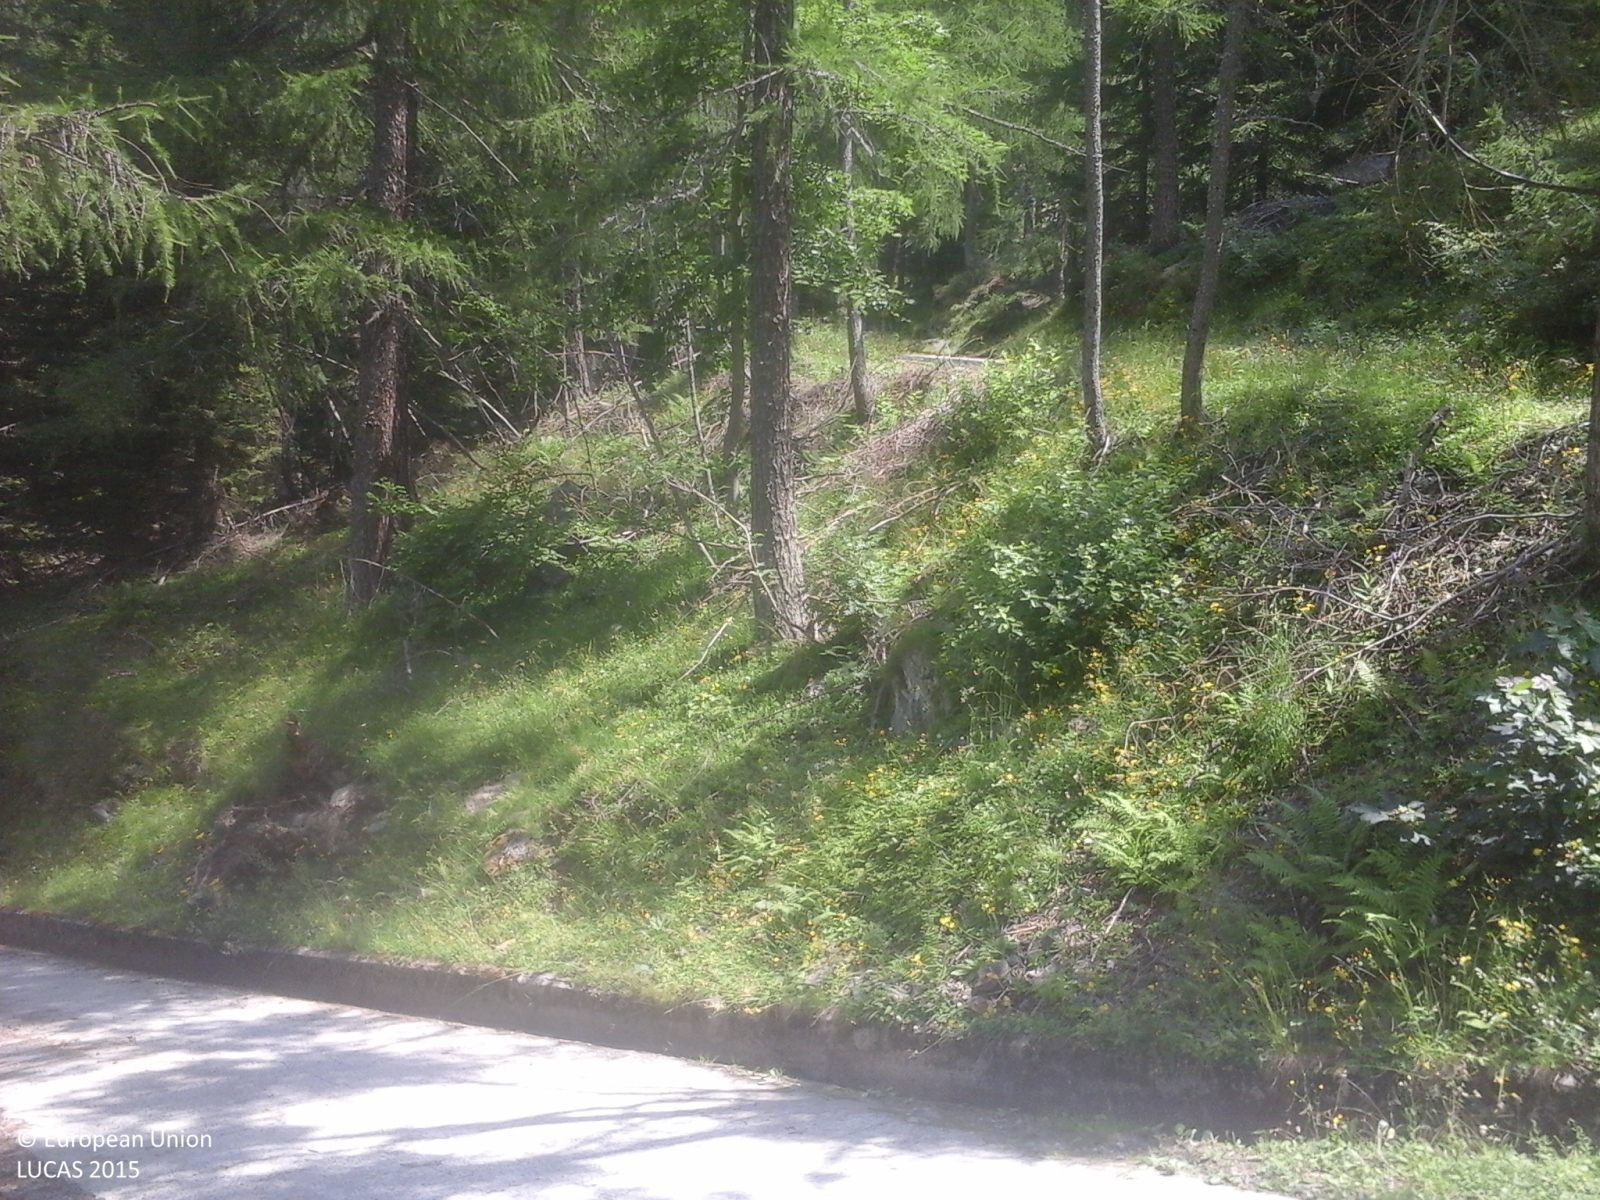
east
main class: Woodland
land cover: Spruce dominated mixed woodland
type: alpine coniferous forest
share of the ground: > 75 %
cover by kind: coniferous forest trees 75 %, broadleaved forest trees 25 %
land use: Forestry
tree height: > 5 m
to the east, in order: Spruce dominated mixed woodland; Paved roads, cycling and walking lanes; Spruce dominated mixed woodland; Paved roads, cycling and walking lanes; Spruce dominated mixed woodland
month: July
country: IT
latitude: 46.3853
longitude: 9.3637
